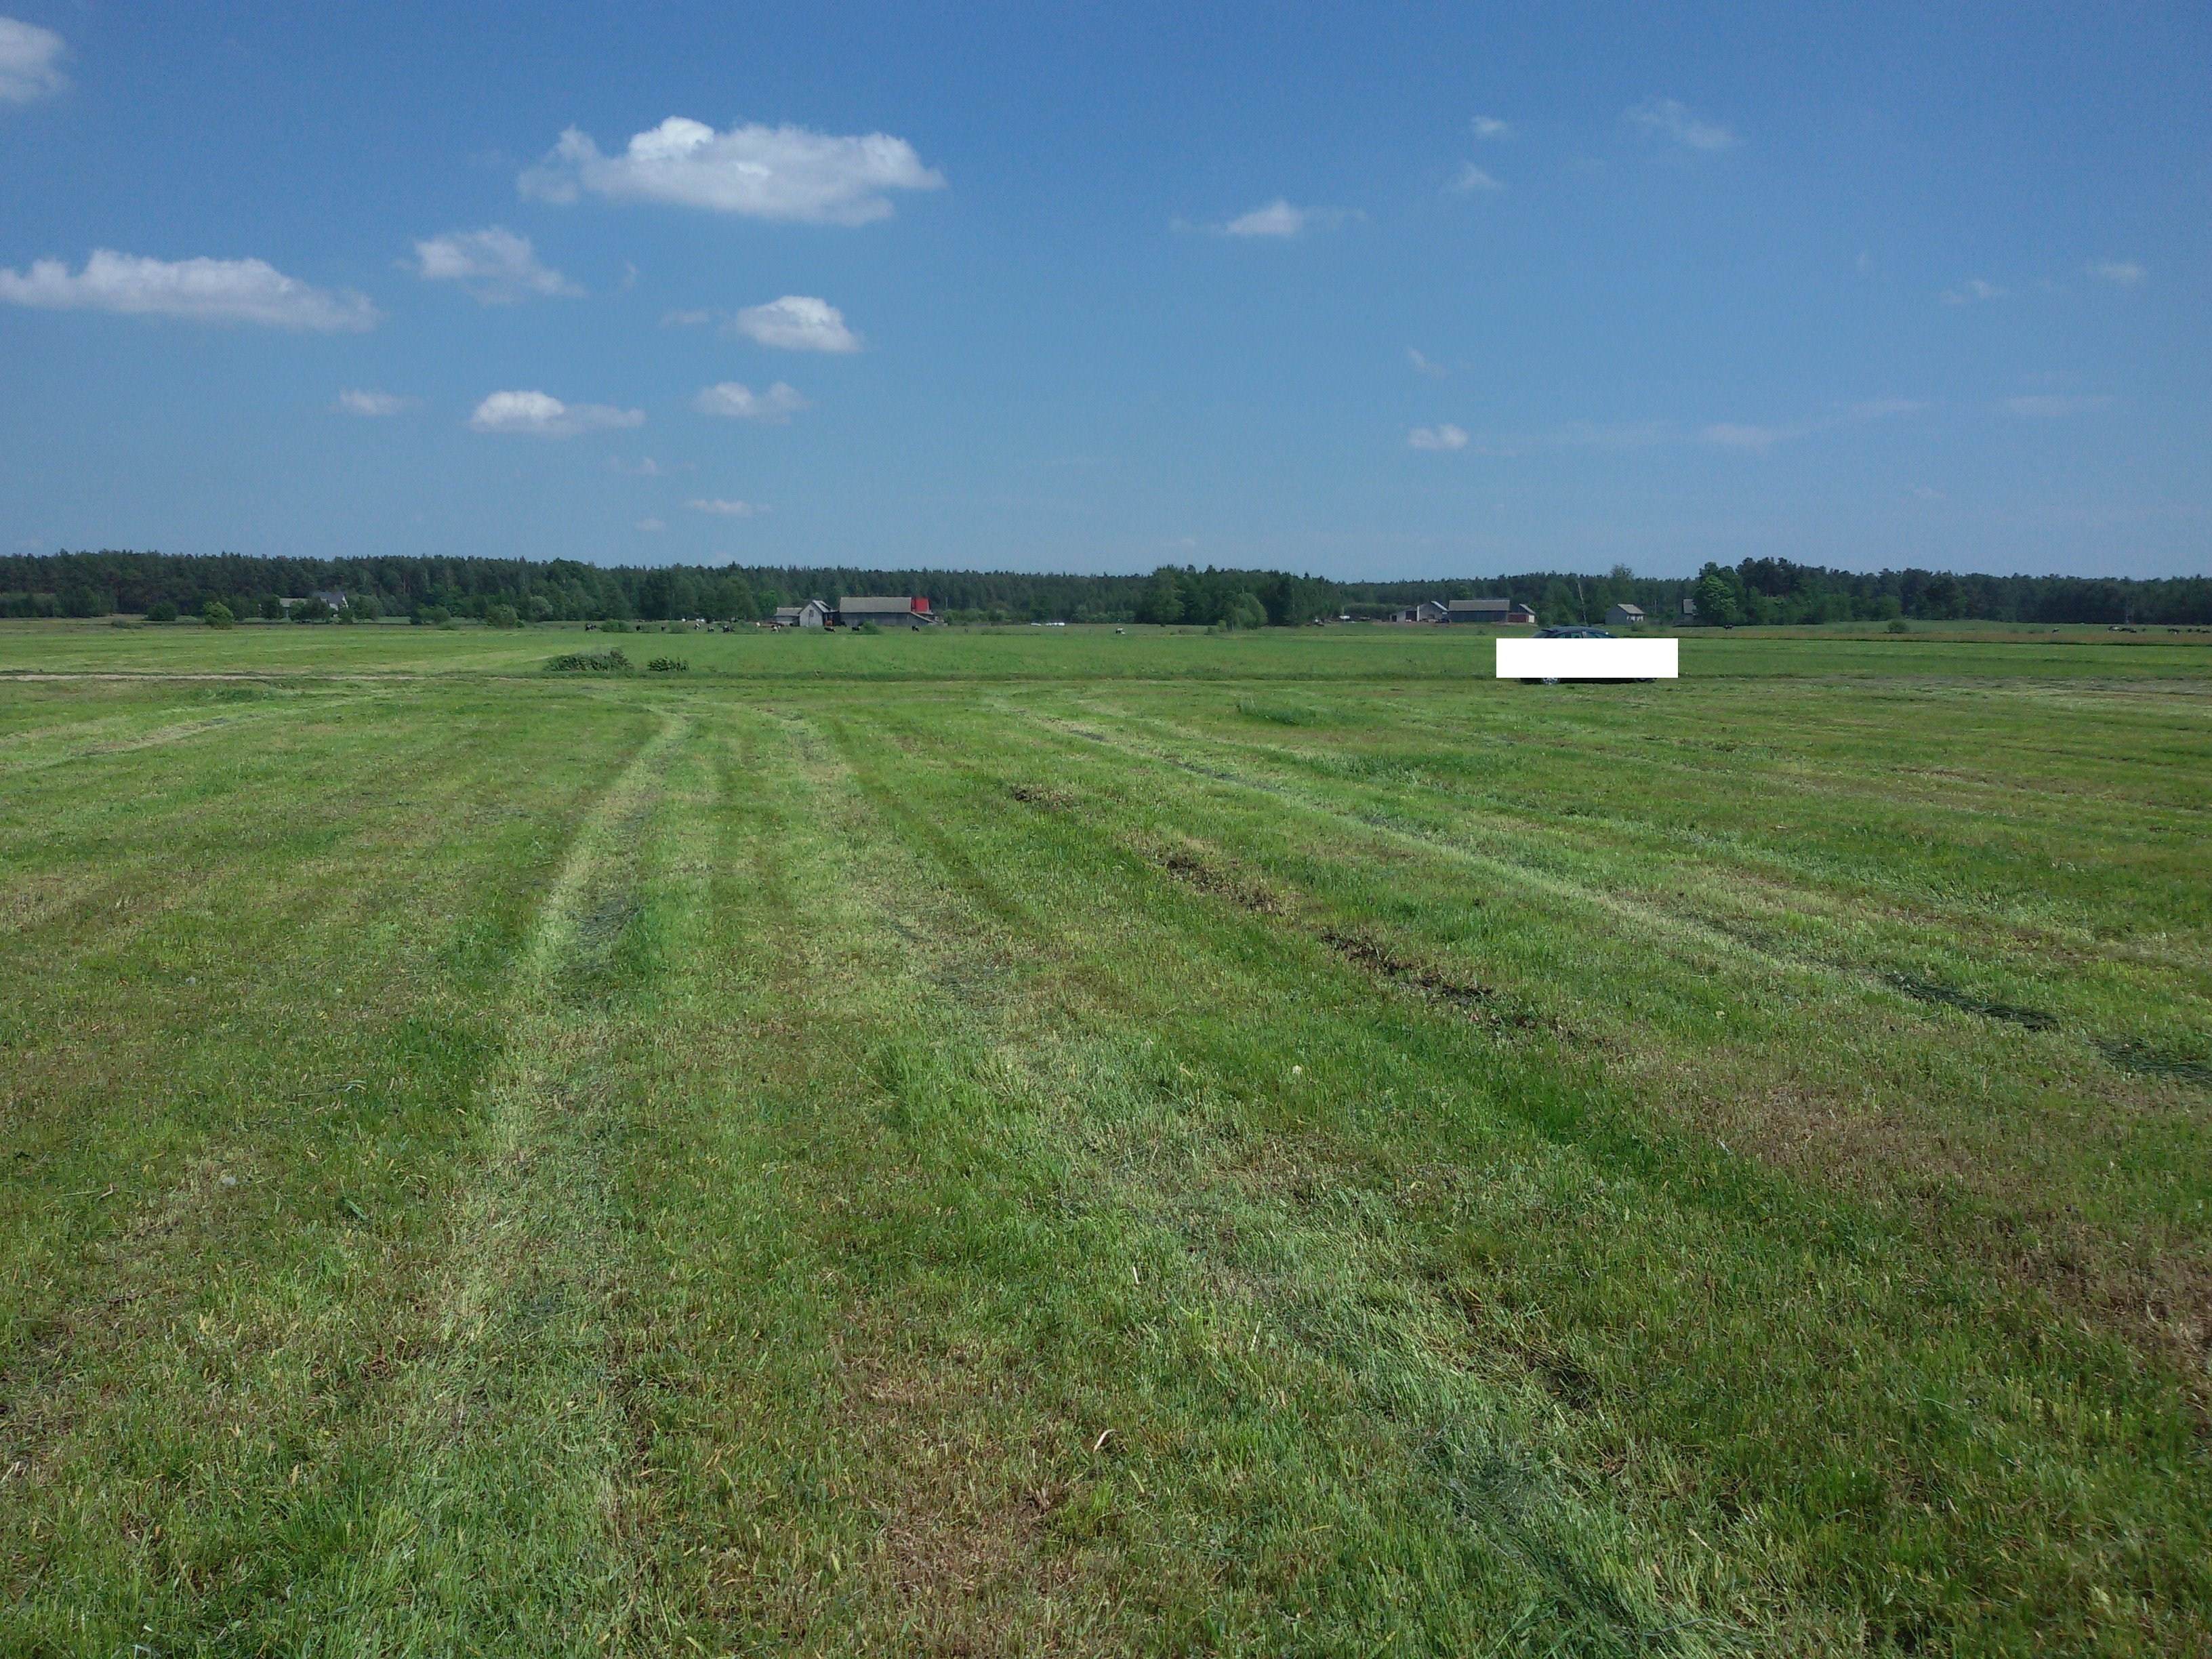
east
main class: Grassland
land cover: Grassland without tree/shrub cover
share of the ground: > 75 %
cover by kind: herbaceous plants 100 %
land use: Agriculture (excluding fallow land and kitchen gardens)
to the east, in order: Grassland without tree/shrub cover; Tracks; Grass margins; Ditches and canals; Grassland without tree/shrub cover
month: June
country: PL
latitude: 53.4152
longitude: 21.4997
